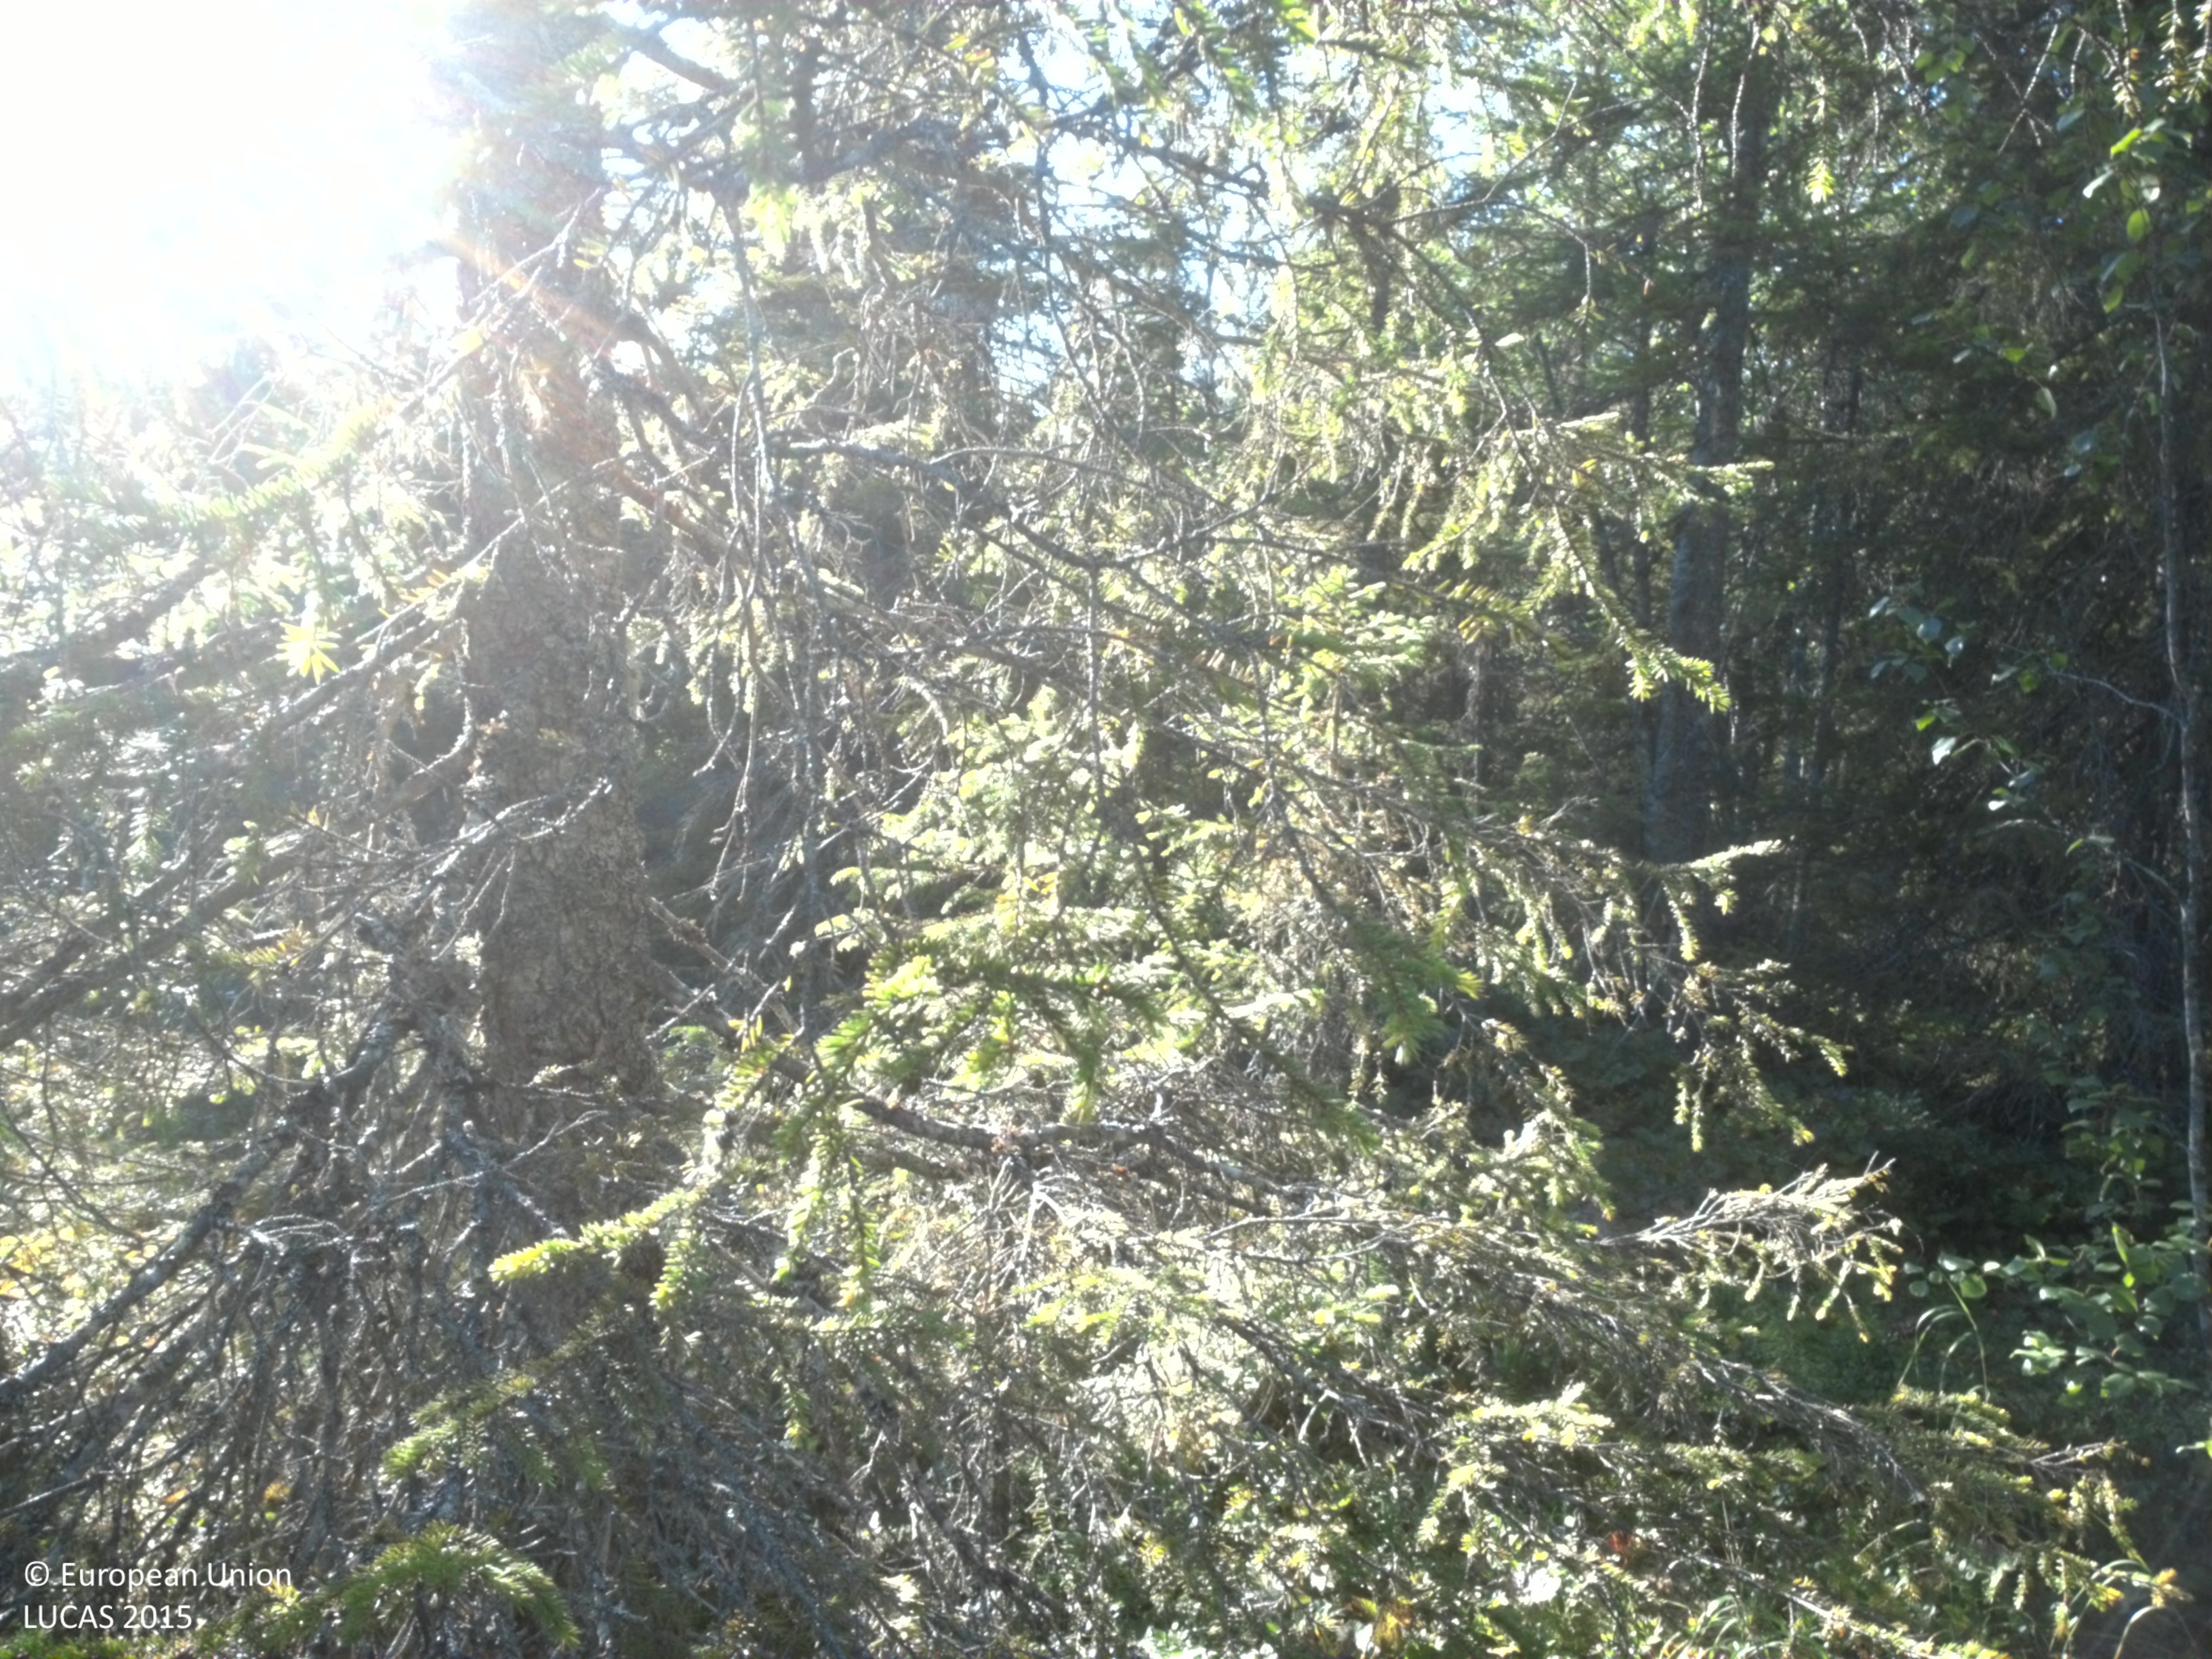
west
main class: Woodland
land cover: Spruce dominated mixed woodland
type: boreal forest
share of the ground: 50 - 75 %
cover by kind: coniferous forest trees 45 %, shrubs 30 %, broadleaved forest trees 15 %, herbaceous plants 5 %, lichens and mosses 5 %
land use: Forestry
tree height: > 5 m
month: August
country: SE
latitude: 64.4131
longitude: 18.3736
